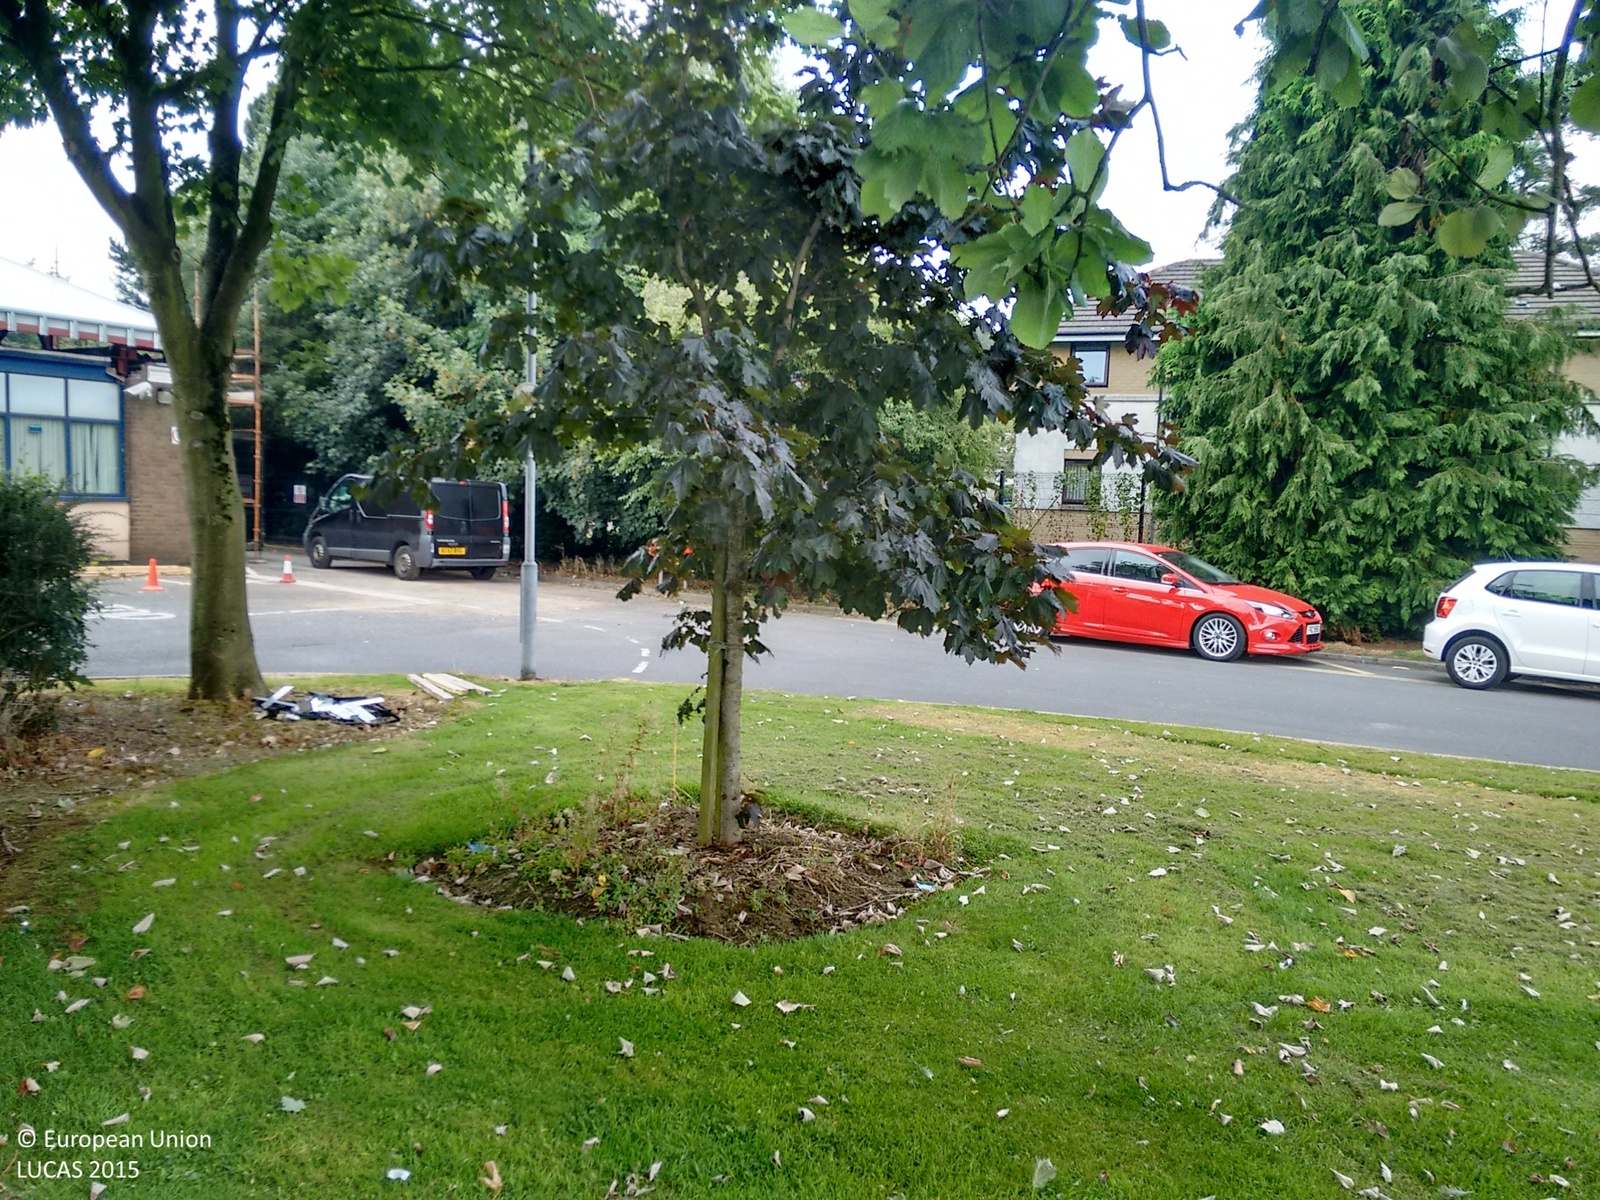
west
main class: Grassland
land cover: Grassland with sparse tree/shrub cover
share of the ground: > 75 %
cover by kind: herbaceous plants 50 %, broadleaved forest trees 5 %
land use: Community services
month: September
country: GB
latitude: 54.7510
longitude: -6.0034
